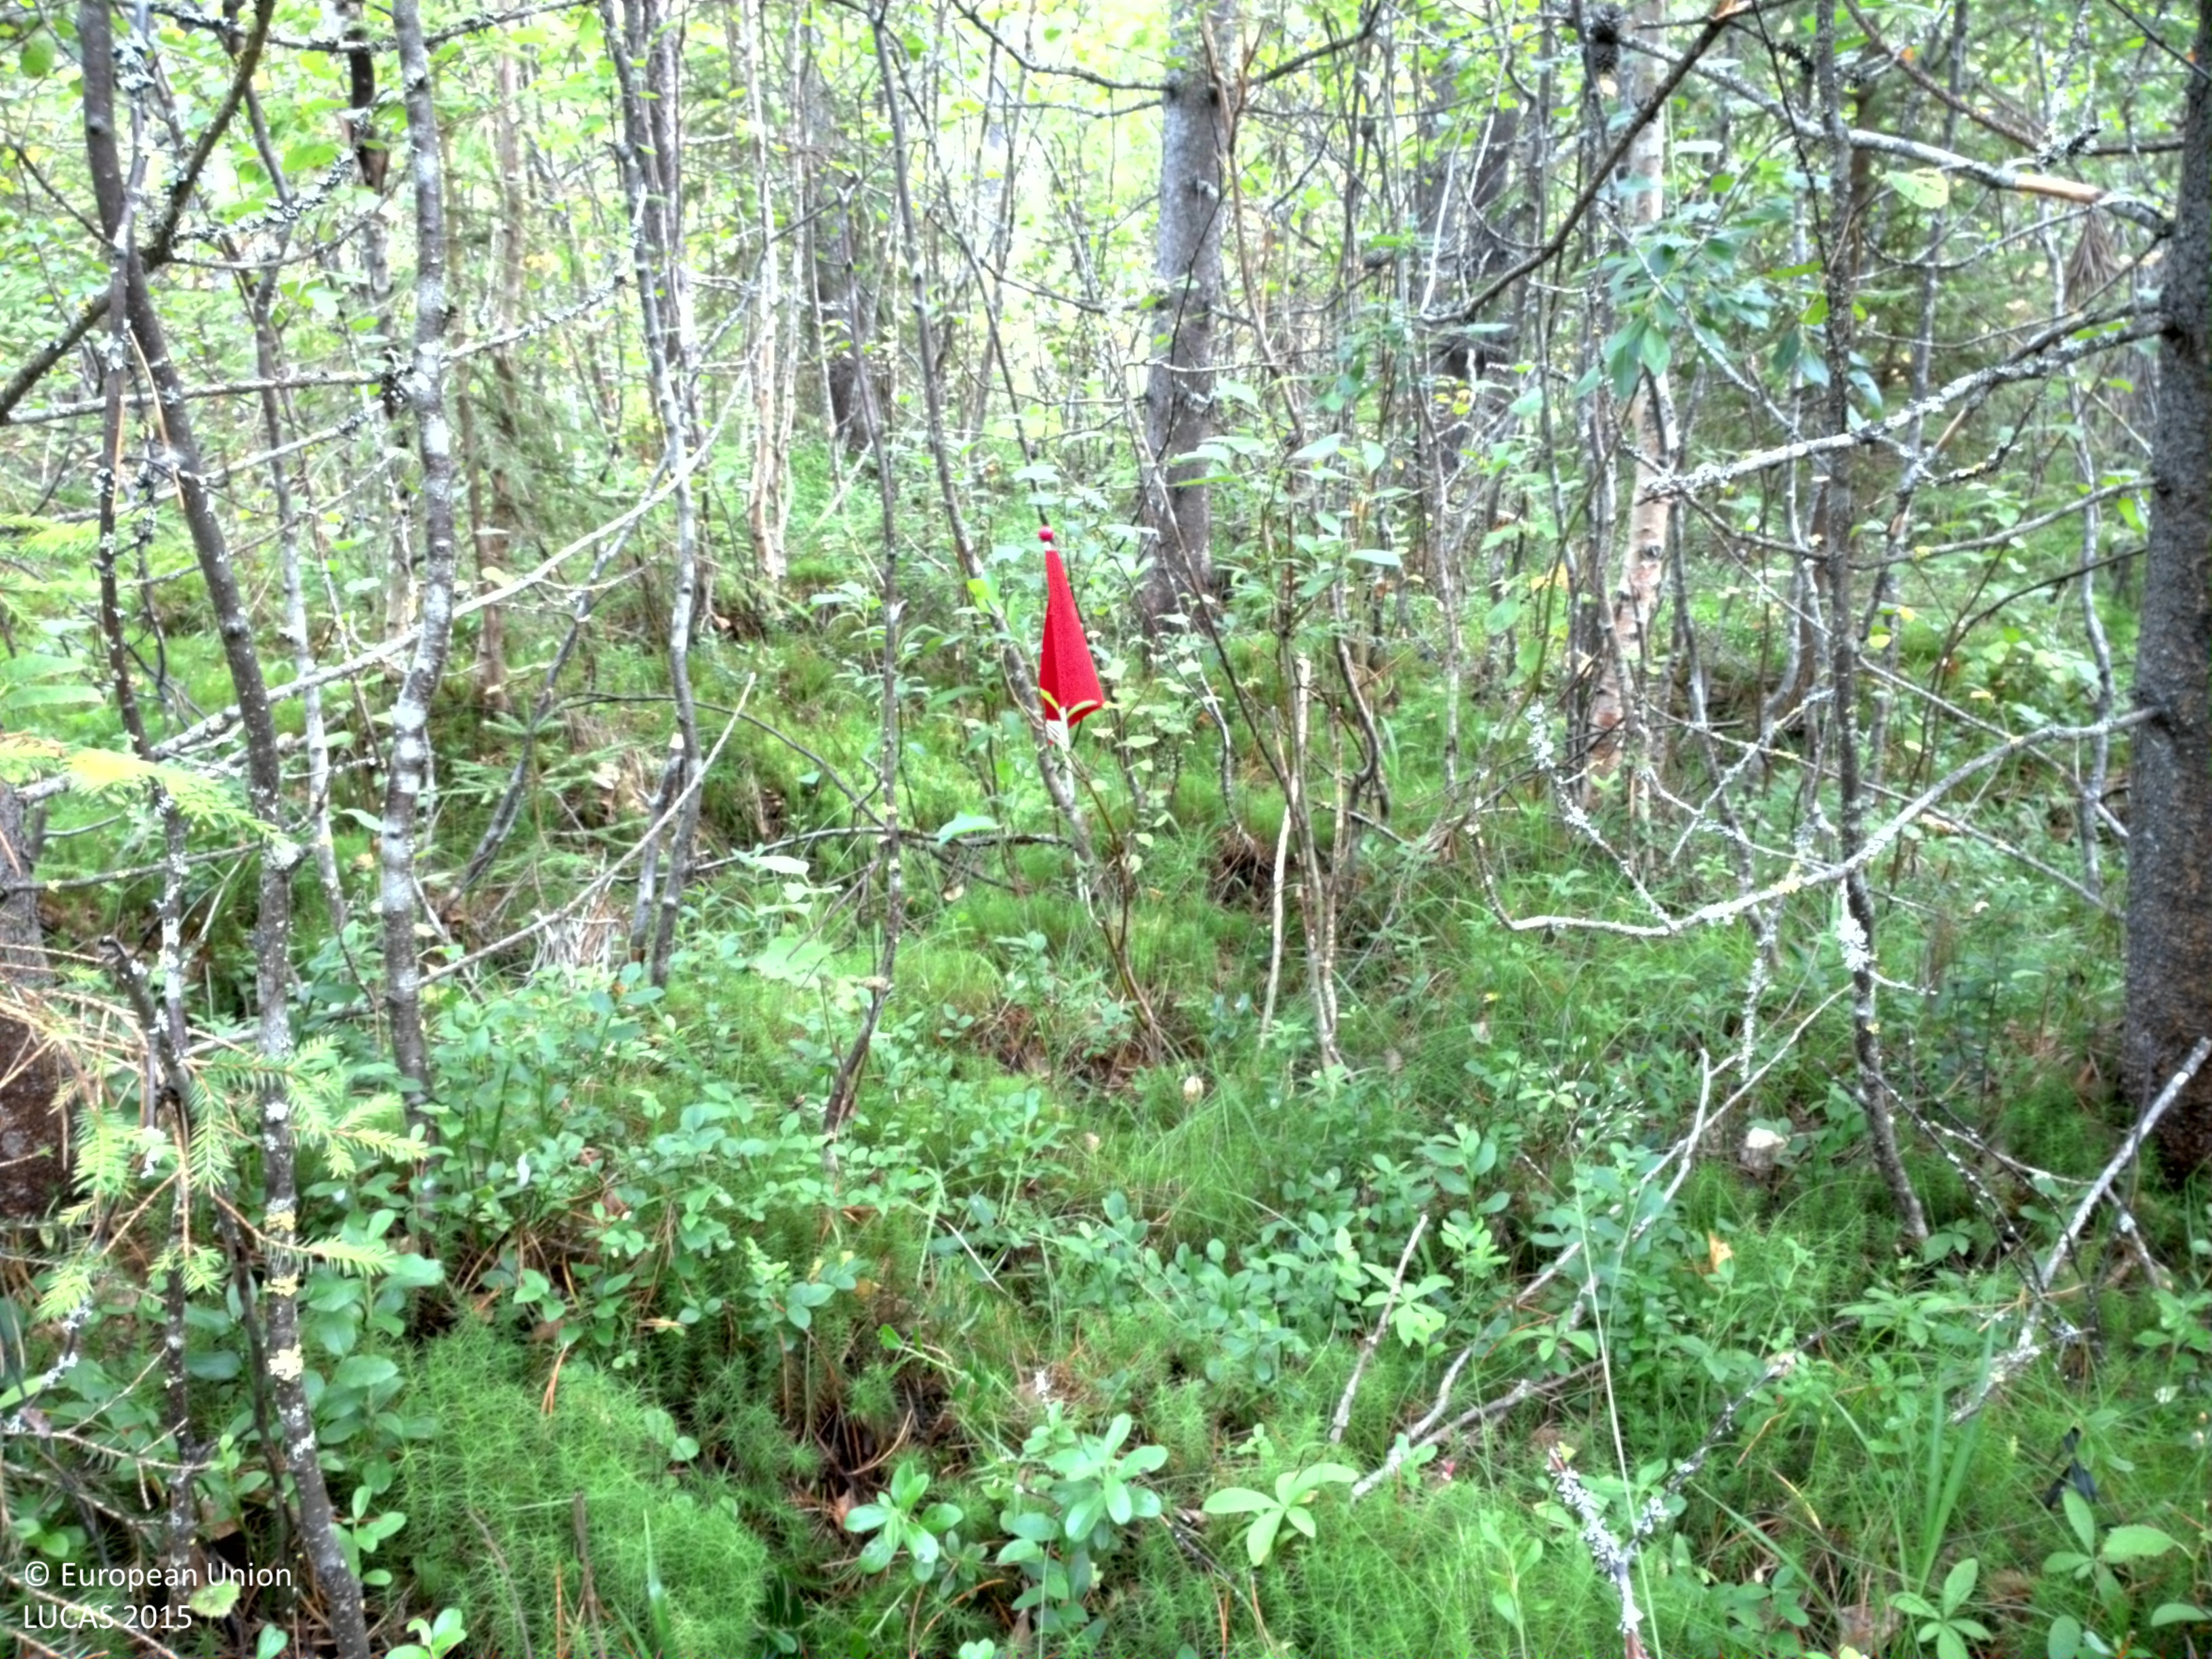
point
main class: Woodland
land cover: Pine dominated mixed woodland
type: exotic forest
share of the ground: > 75 %
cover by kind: broadleaved forest trees 45 %, coniferous forest trees 35 %, shrubs 20 %
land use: Forestry
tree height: > 5 m
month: August
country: SE
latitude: 66.0427
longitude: 22.5806
